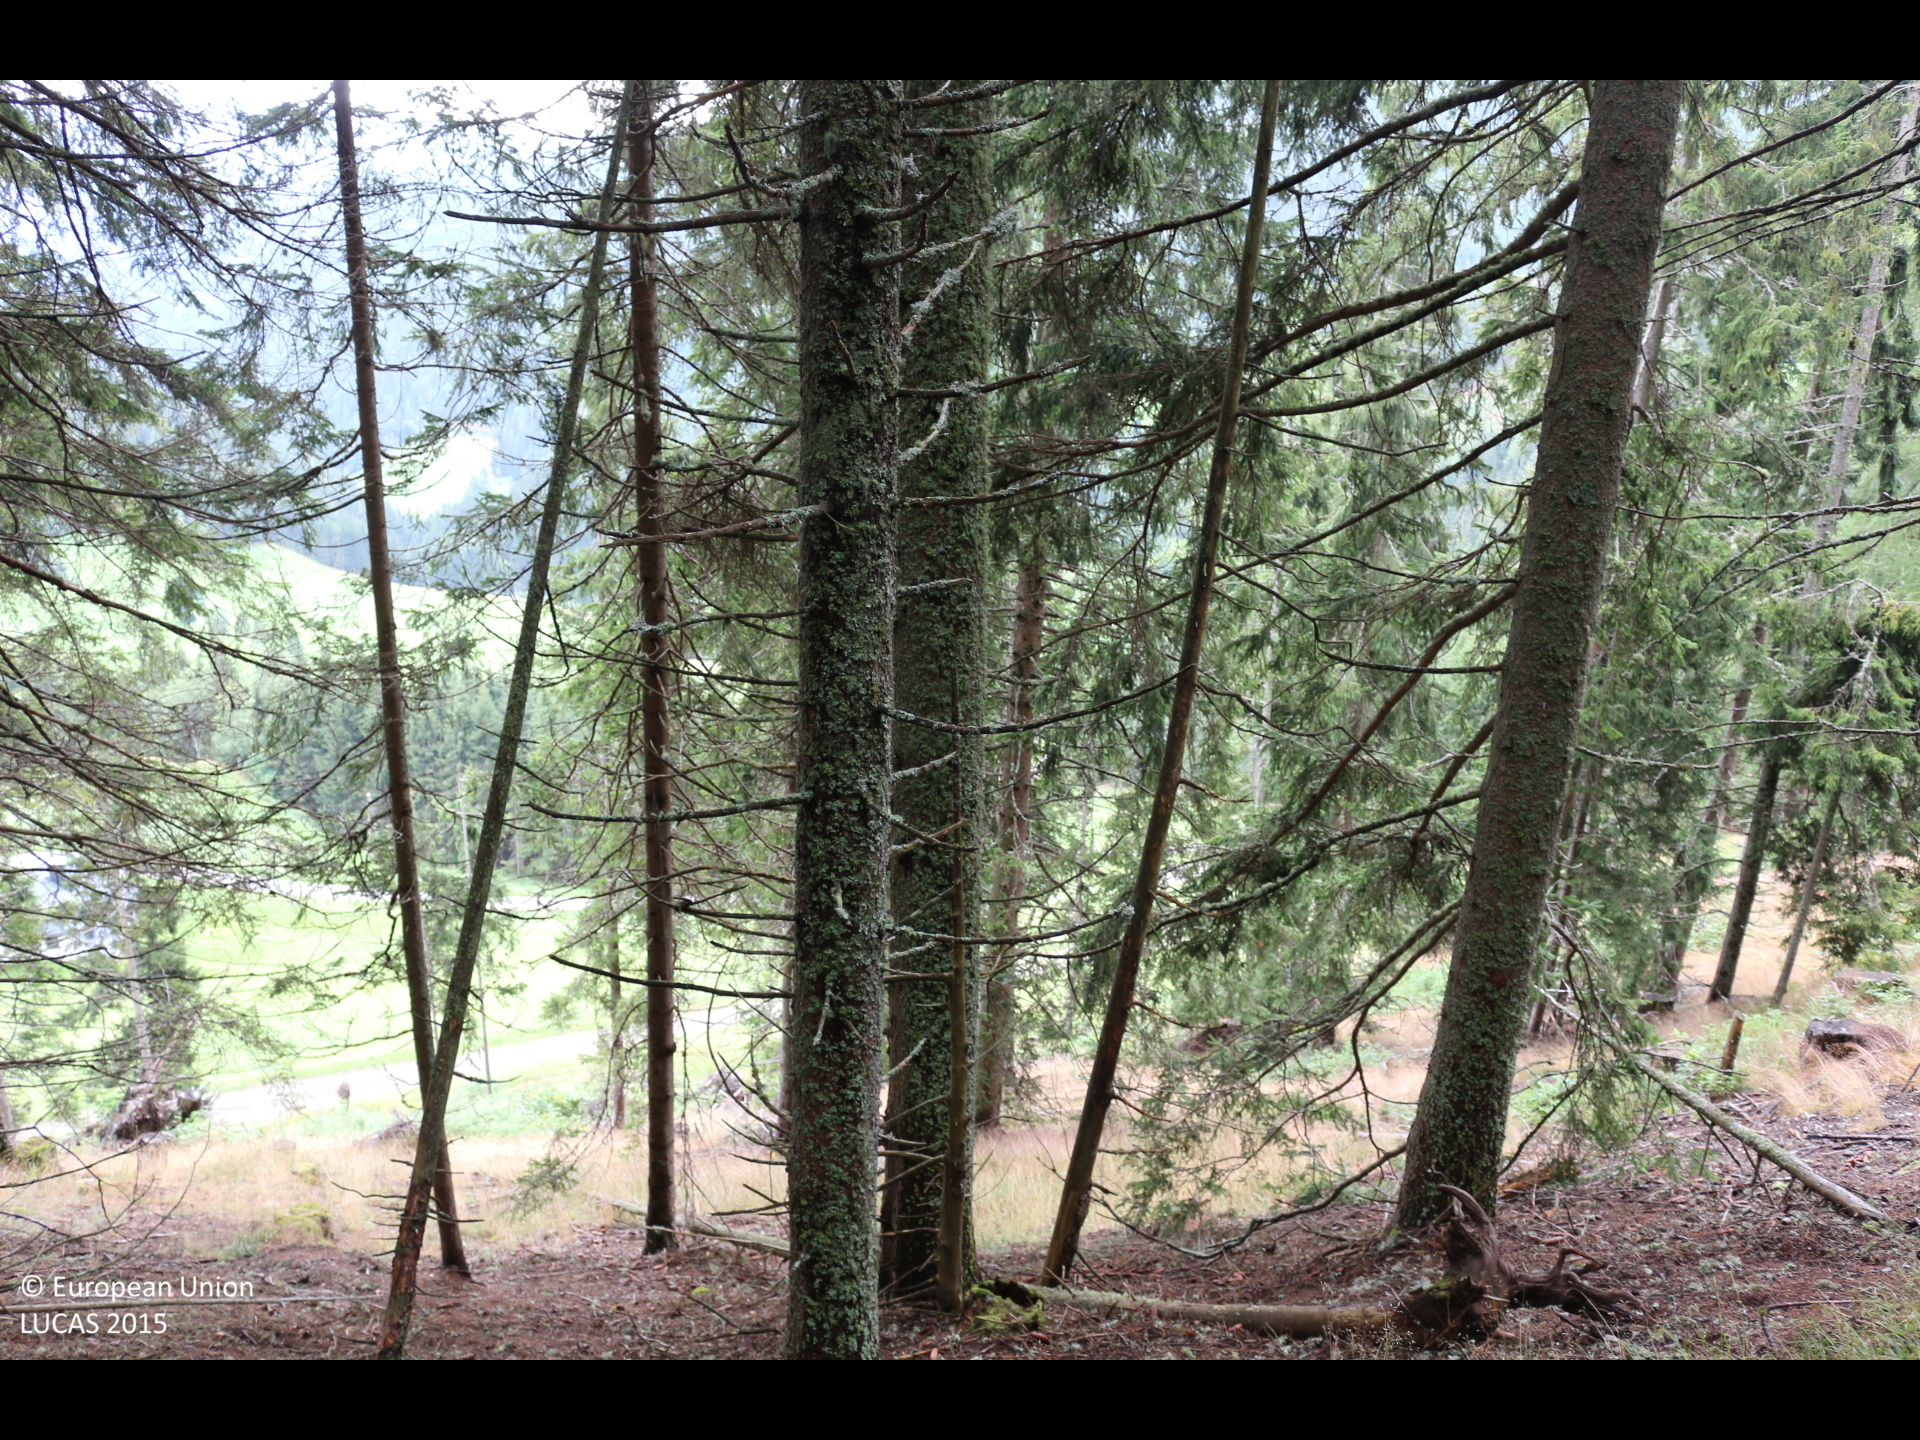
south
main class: Woodland
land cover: Spruce dominated coniferous woodland
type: alpine coniferous forest
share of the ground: > 75 %
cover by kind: coniferous forest trees 95 %, herbaceous plants 5 %
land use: Forestry
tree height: > 5 m
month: July
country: AT
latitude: 47.0242
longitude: 14.2478
